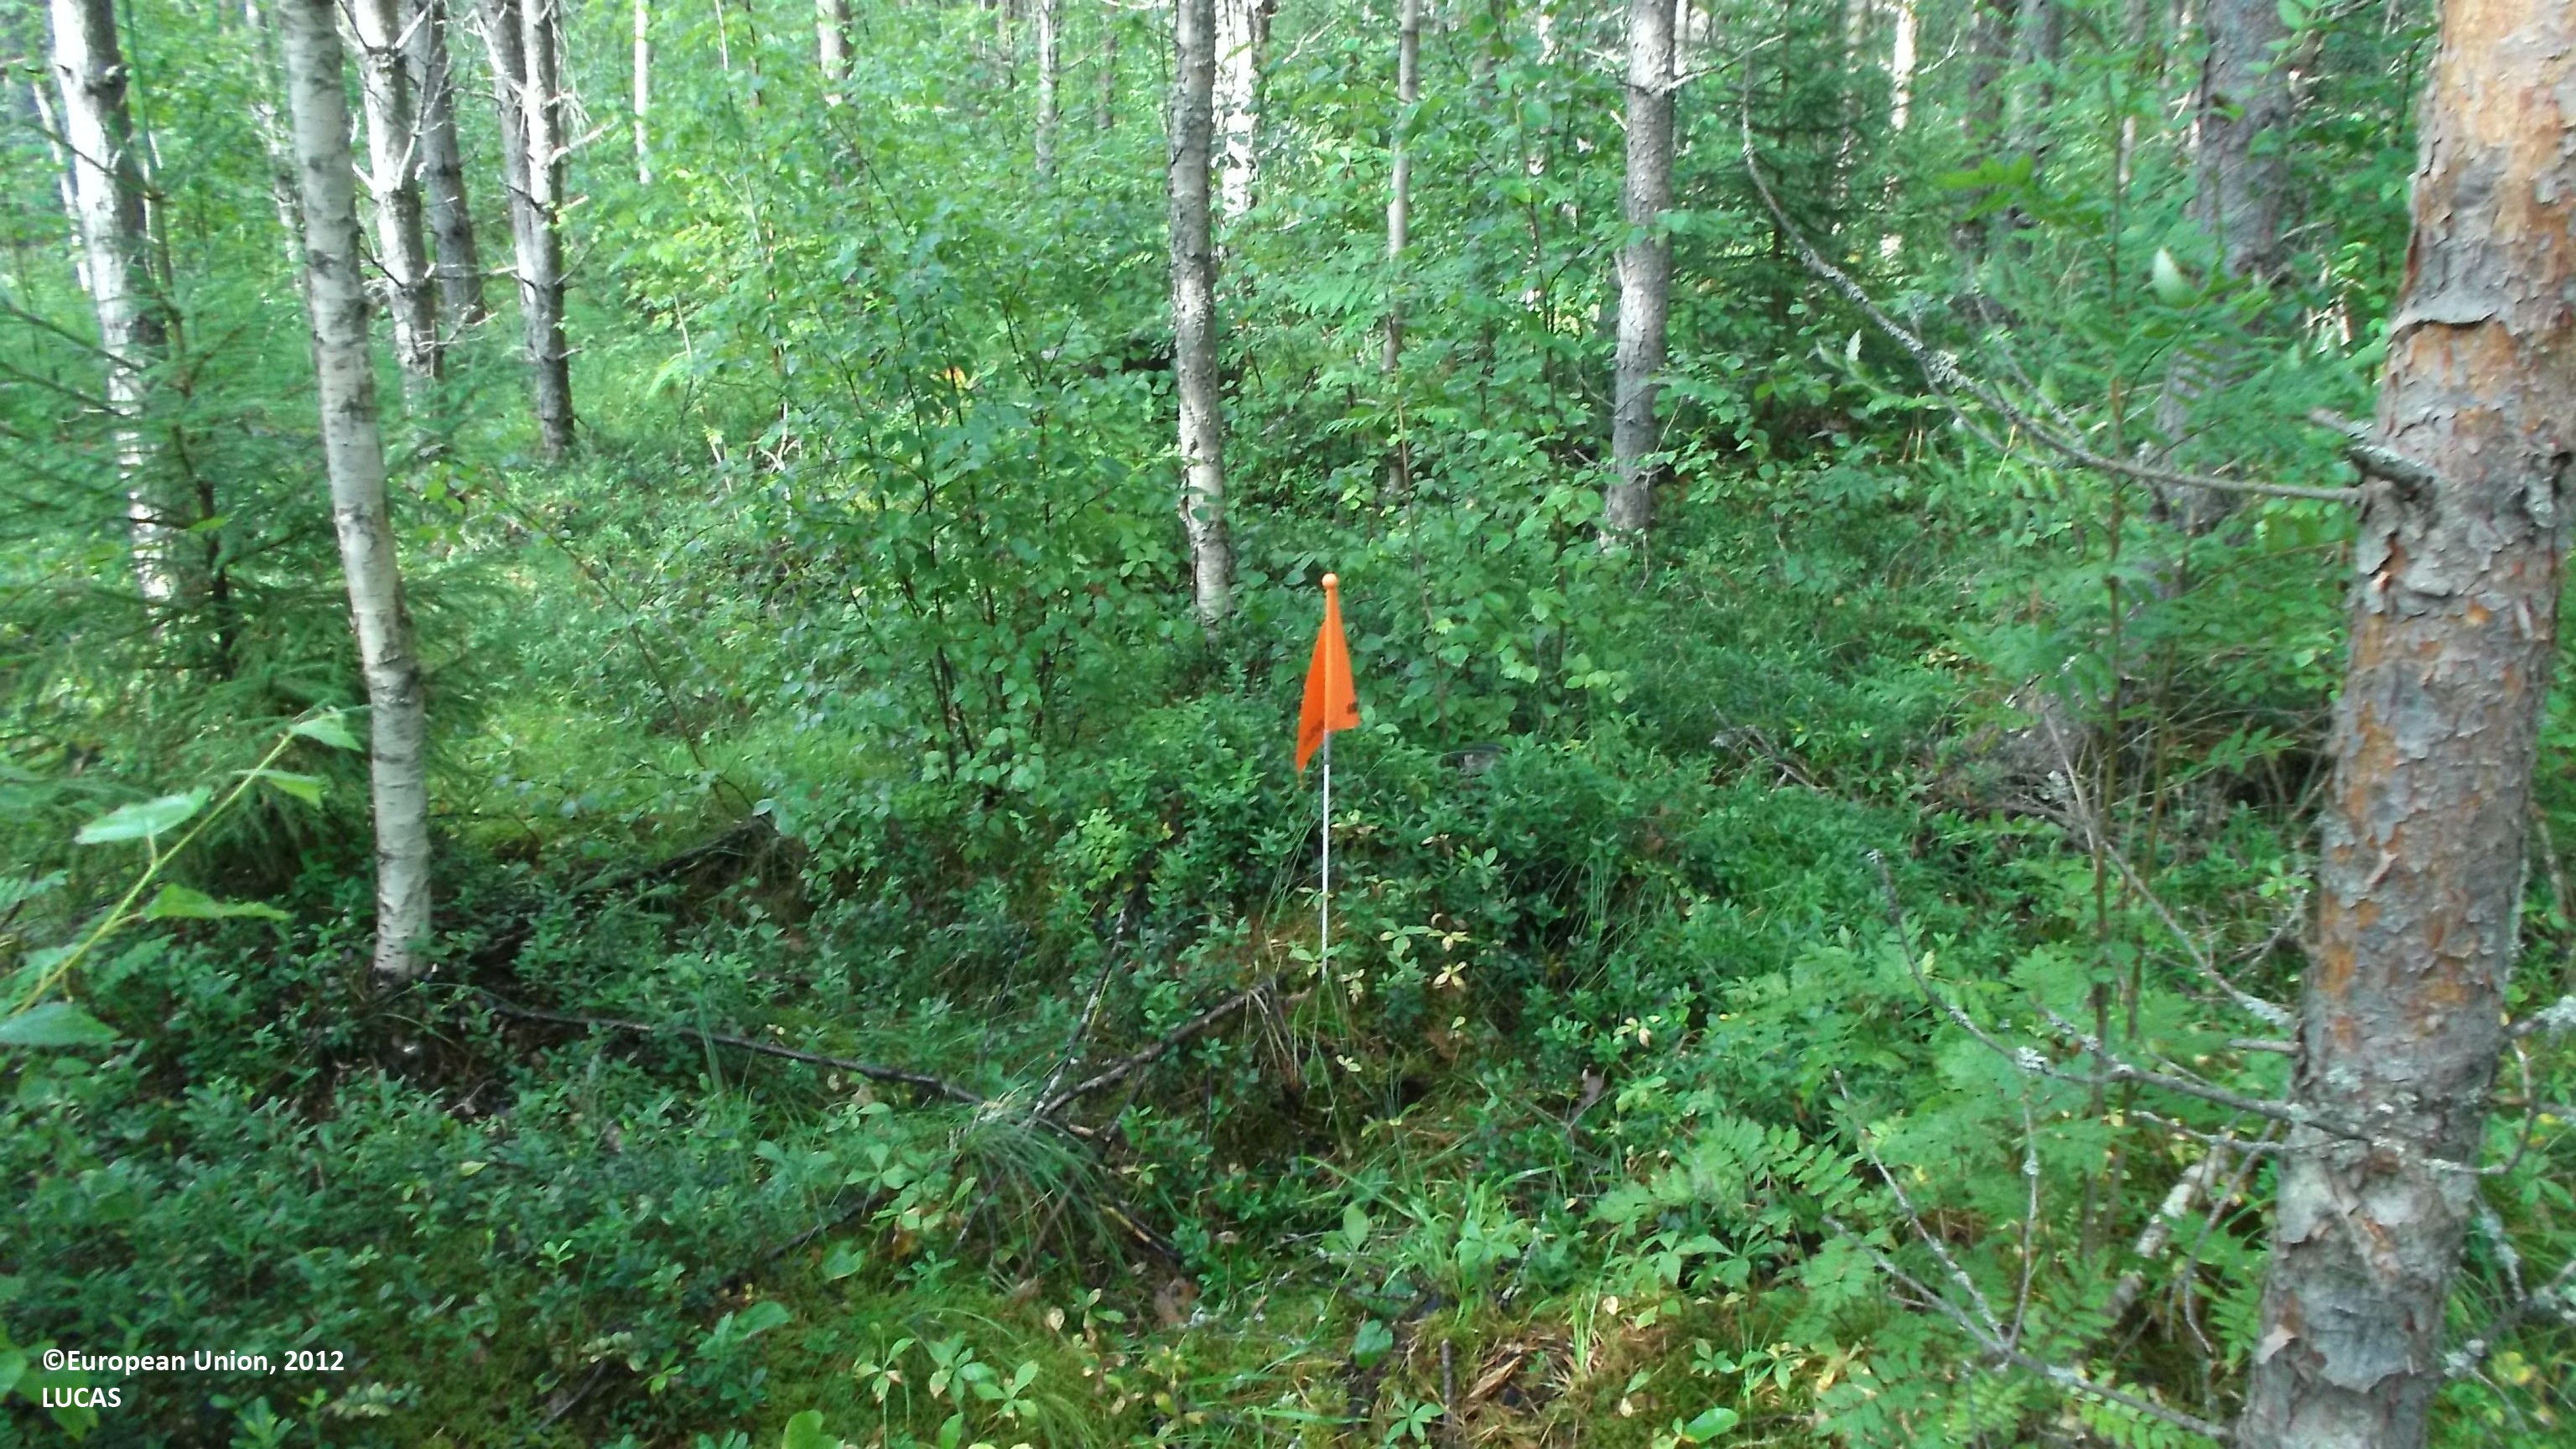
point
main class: Woodland
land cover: Pine dominated coniferous woodland
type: boreal forest
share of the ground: 50 - 75 %
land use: Forestry
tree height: > 5 m
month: August
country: FI
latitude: 63.9320
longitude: 23.4574
